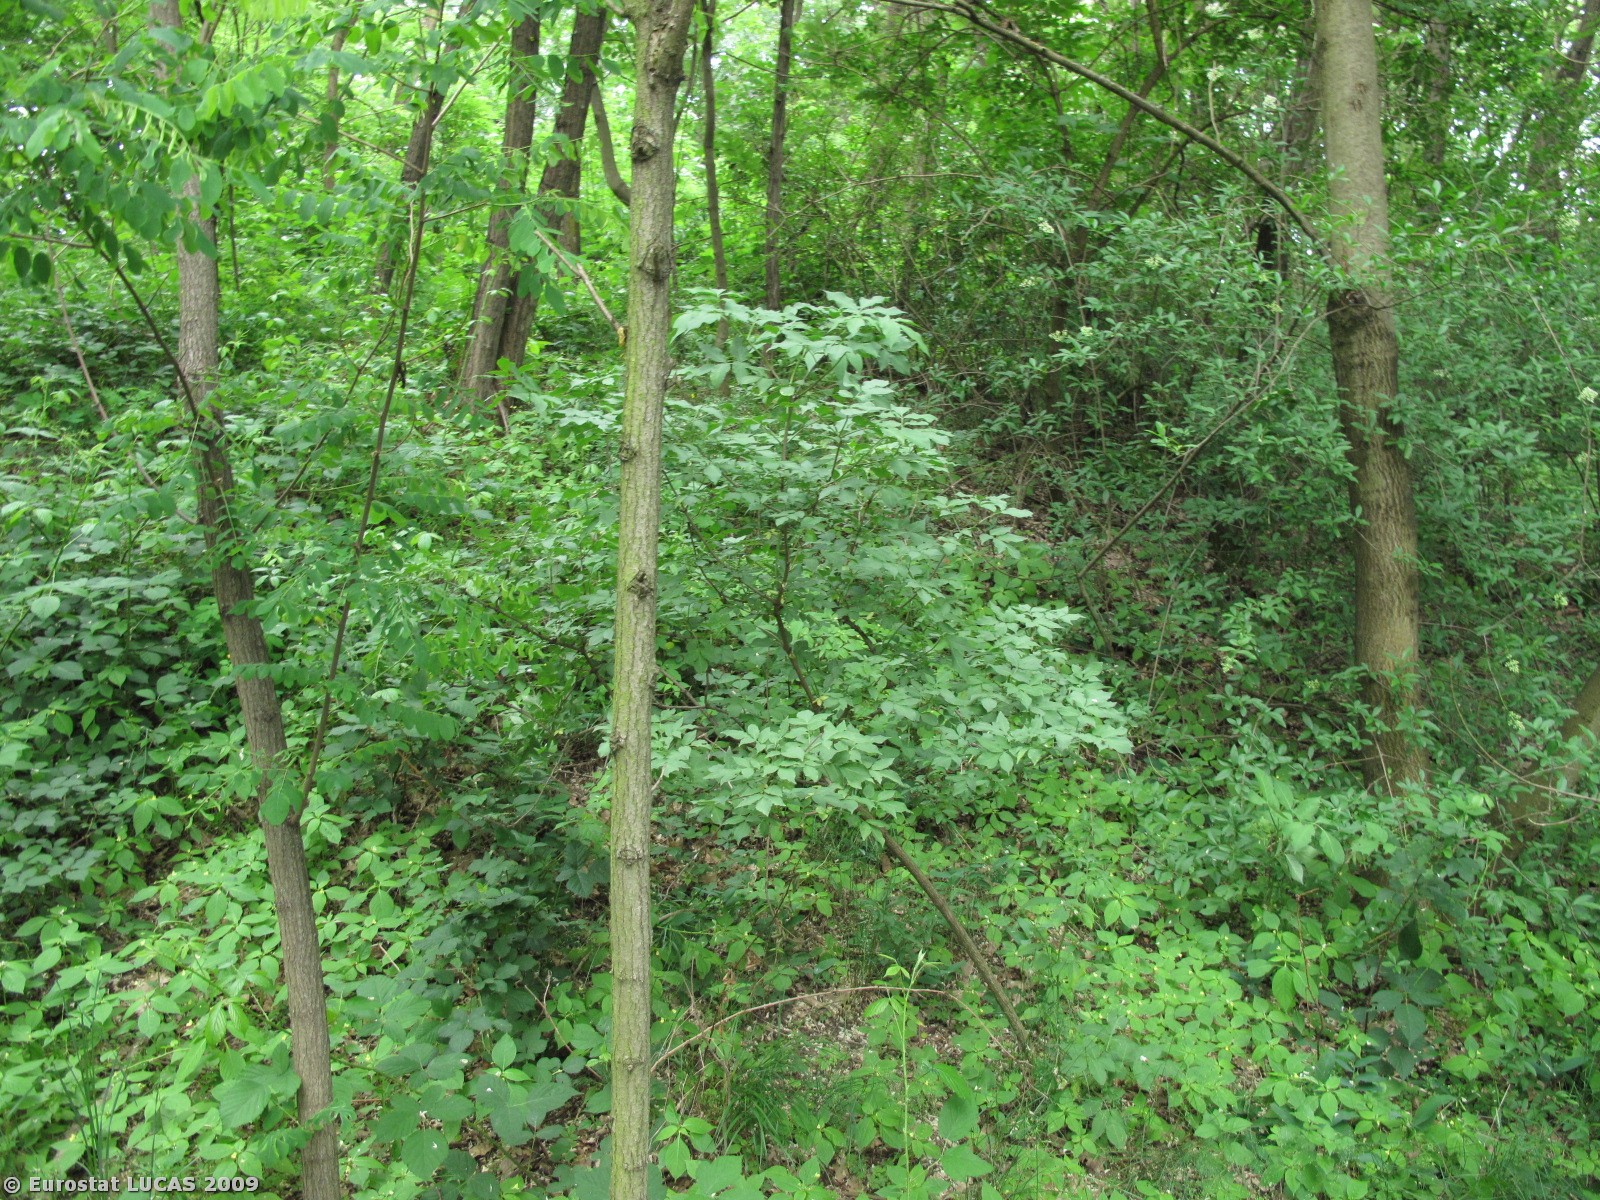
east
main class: Woodland
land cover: Broadleaved woodland
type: mesophytic deciduous forest
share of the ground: 50 - 75 %
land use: Forestry
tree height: > 5 m
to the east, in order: Broadleaved woodland
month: May
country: AT
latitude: 48.5276
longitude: 16.0301
